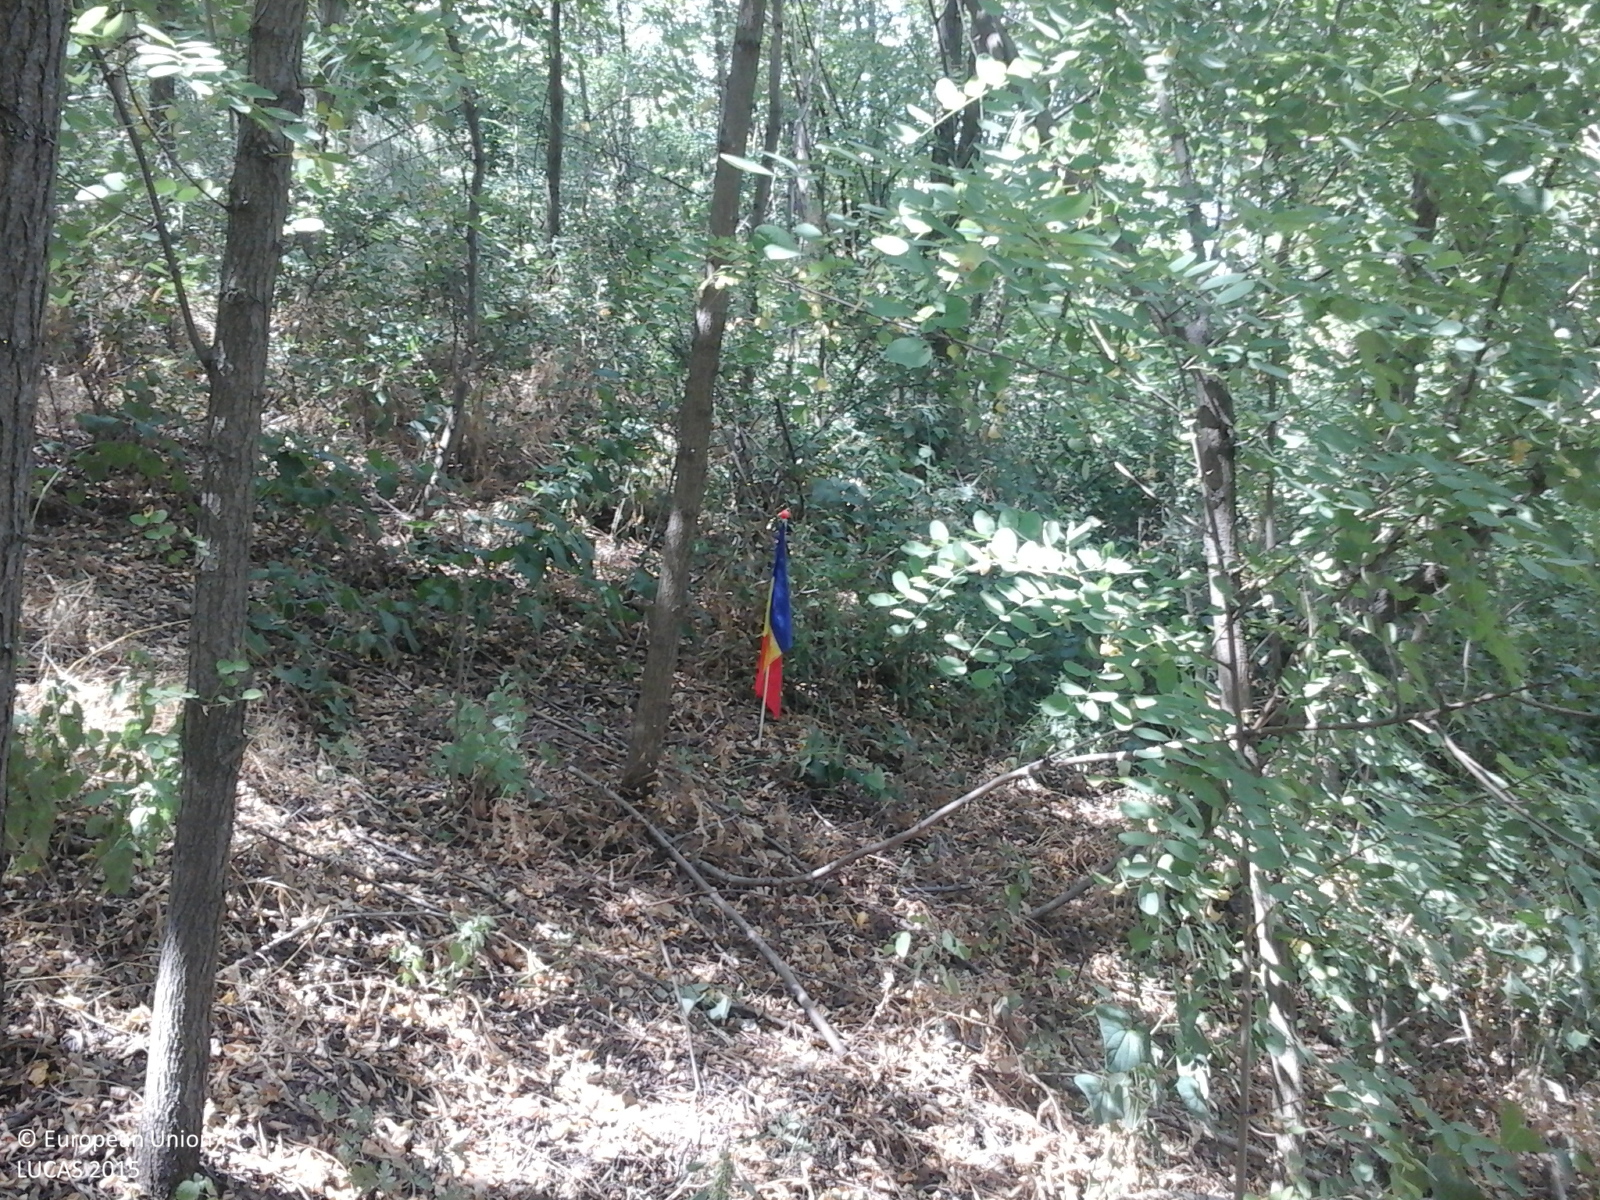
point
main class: Woodland
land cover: Broadleaved woodland
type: exotic forest
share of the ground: > 75 %
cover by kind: broadleaved forest trees 100 %
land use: Forestry
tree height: > 5 m
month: July
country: RO
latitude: 46.5420
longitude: 27.3322
